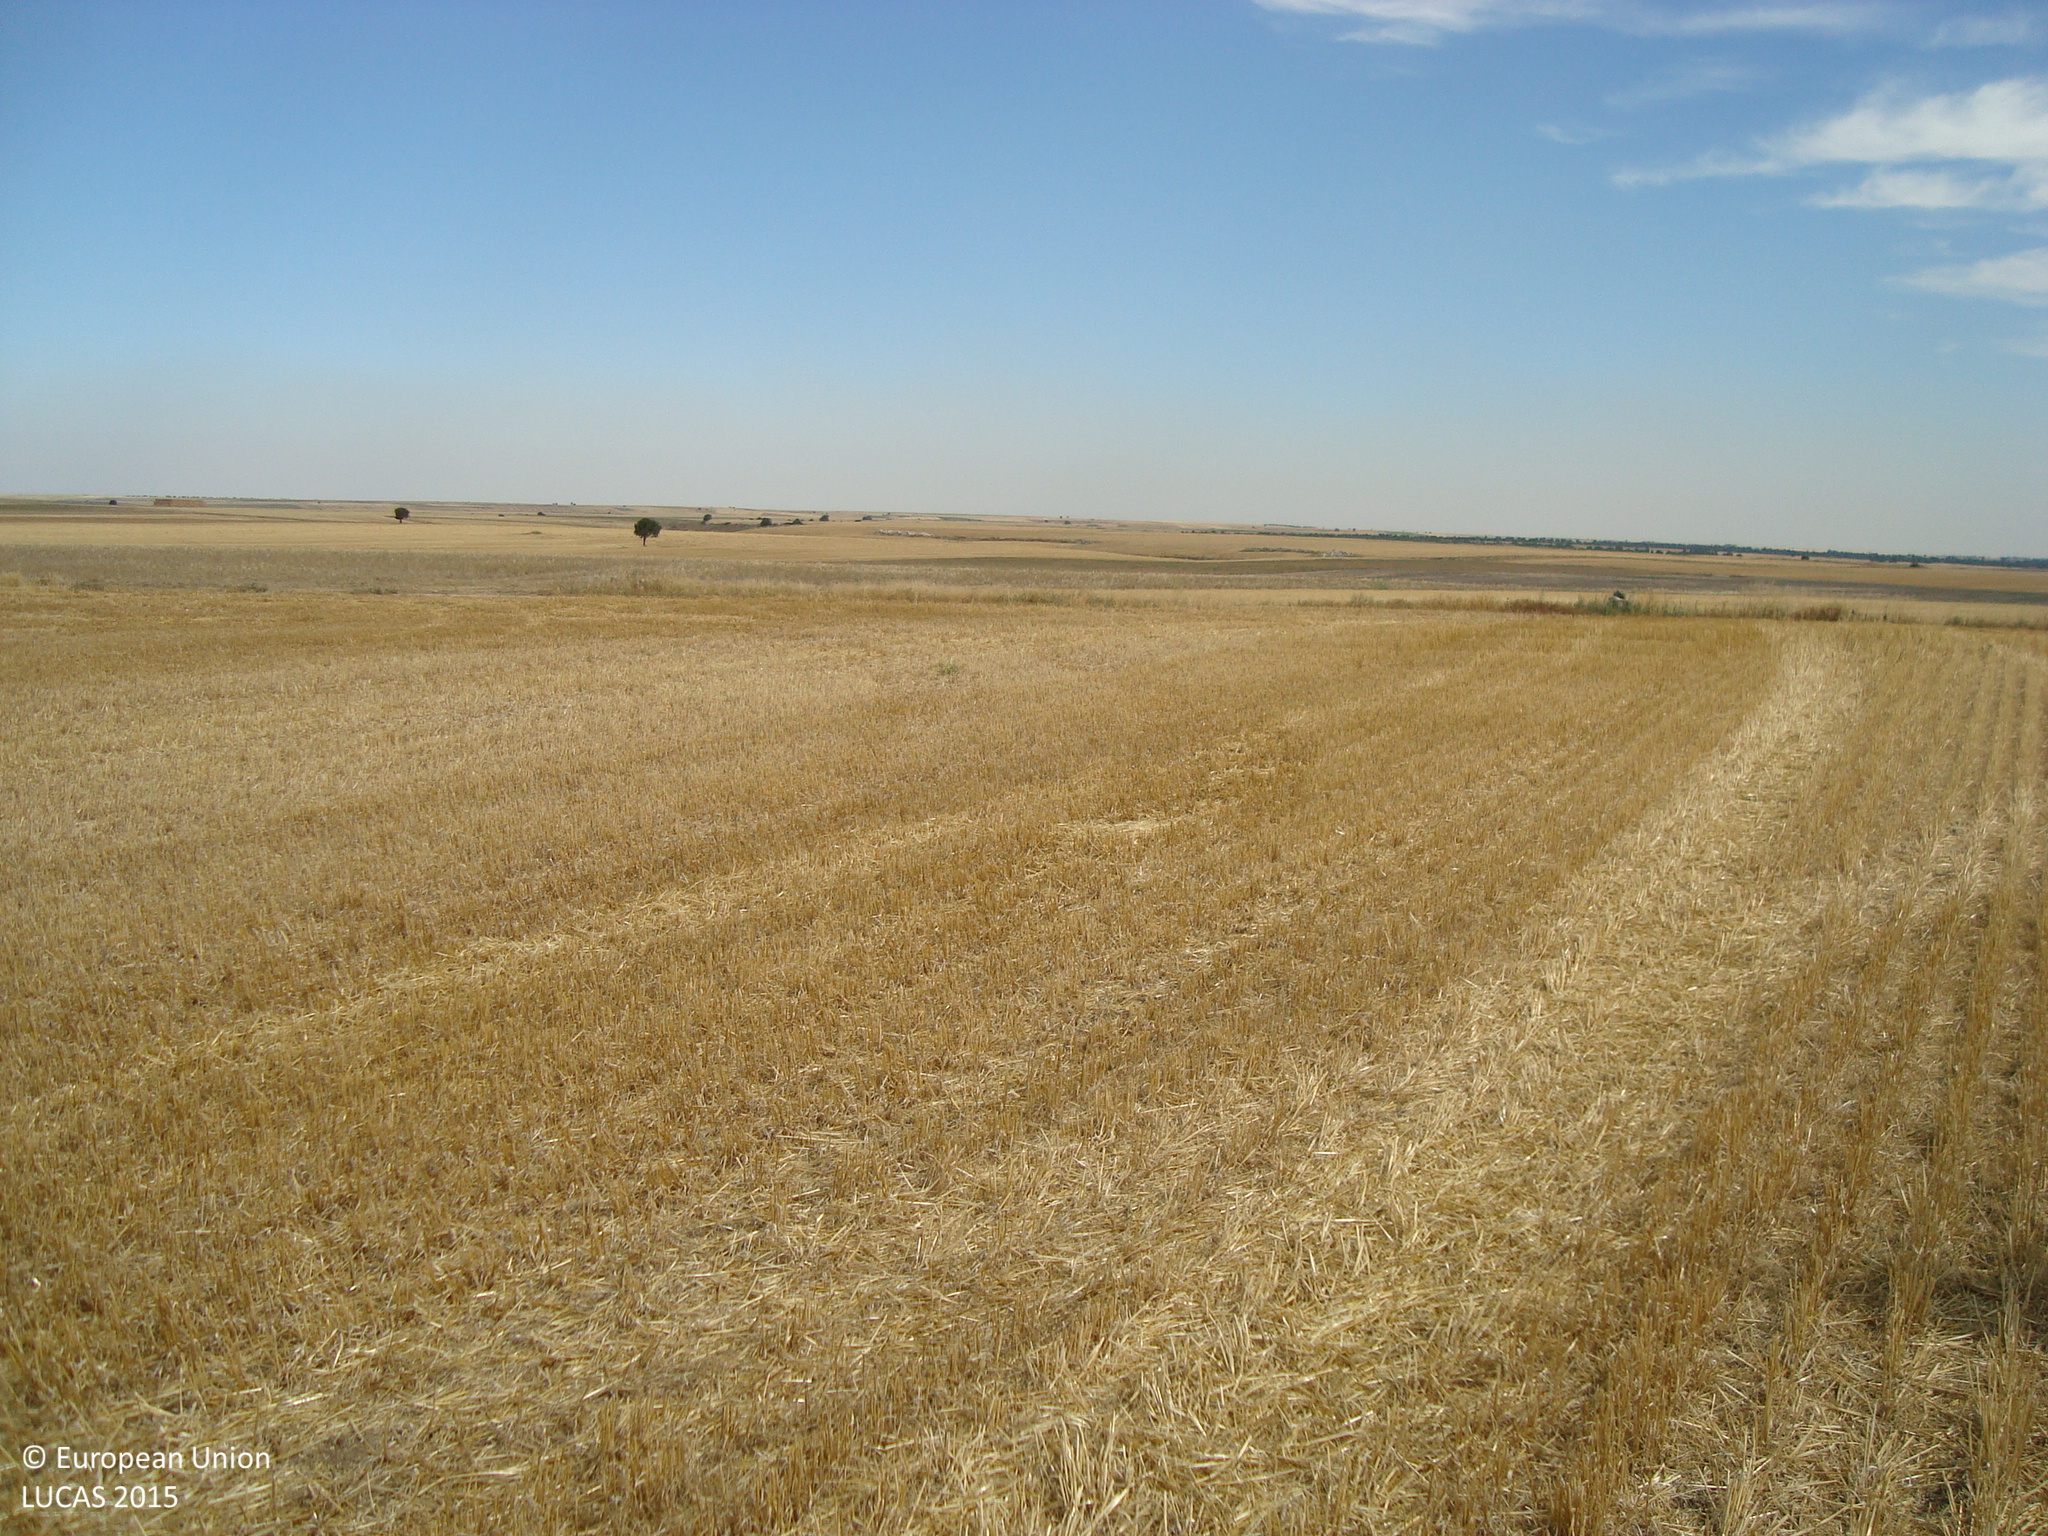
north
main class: Cropland
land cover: Barley
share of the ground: > 75 %
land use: Agriculture (excluding fallow land and kitchen gardens)
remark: Harvested field
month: July
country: ES
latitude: 41.8974
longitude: -3.8591
